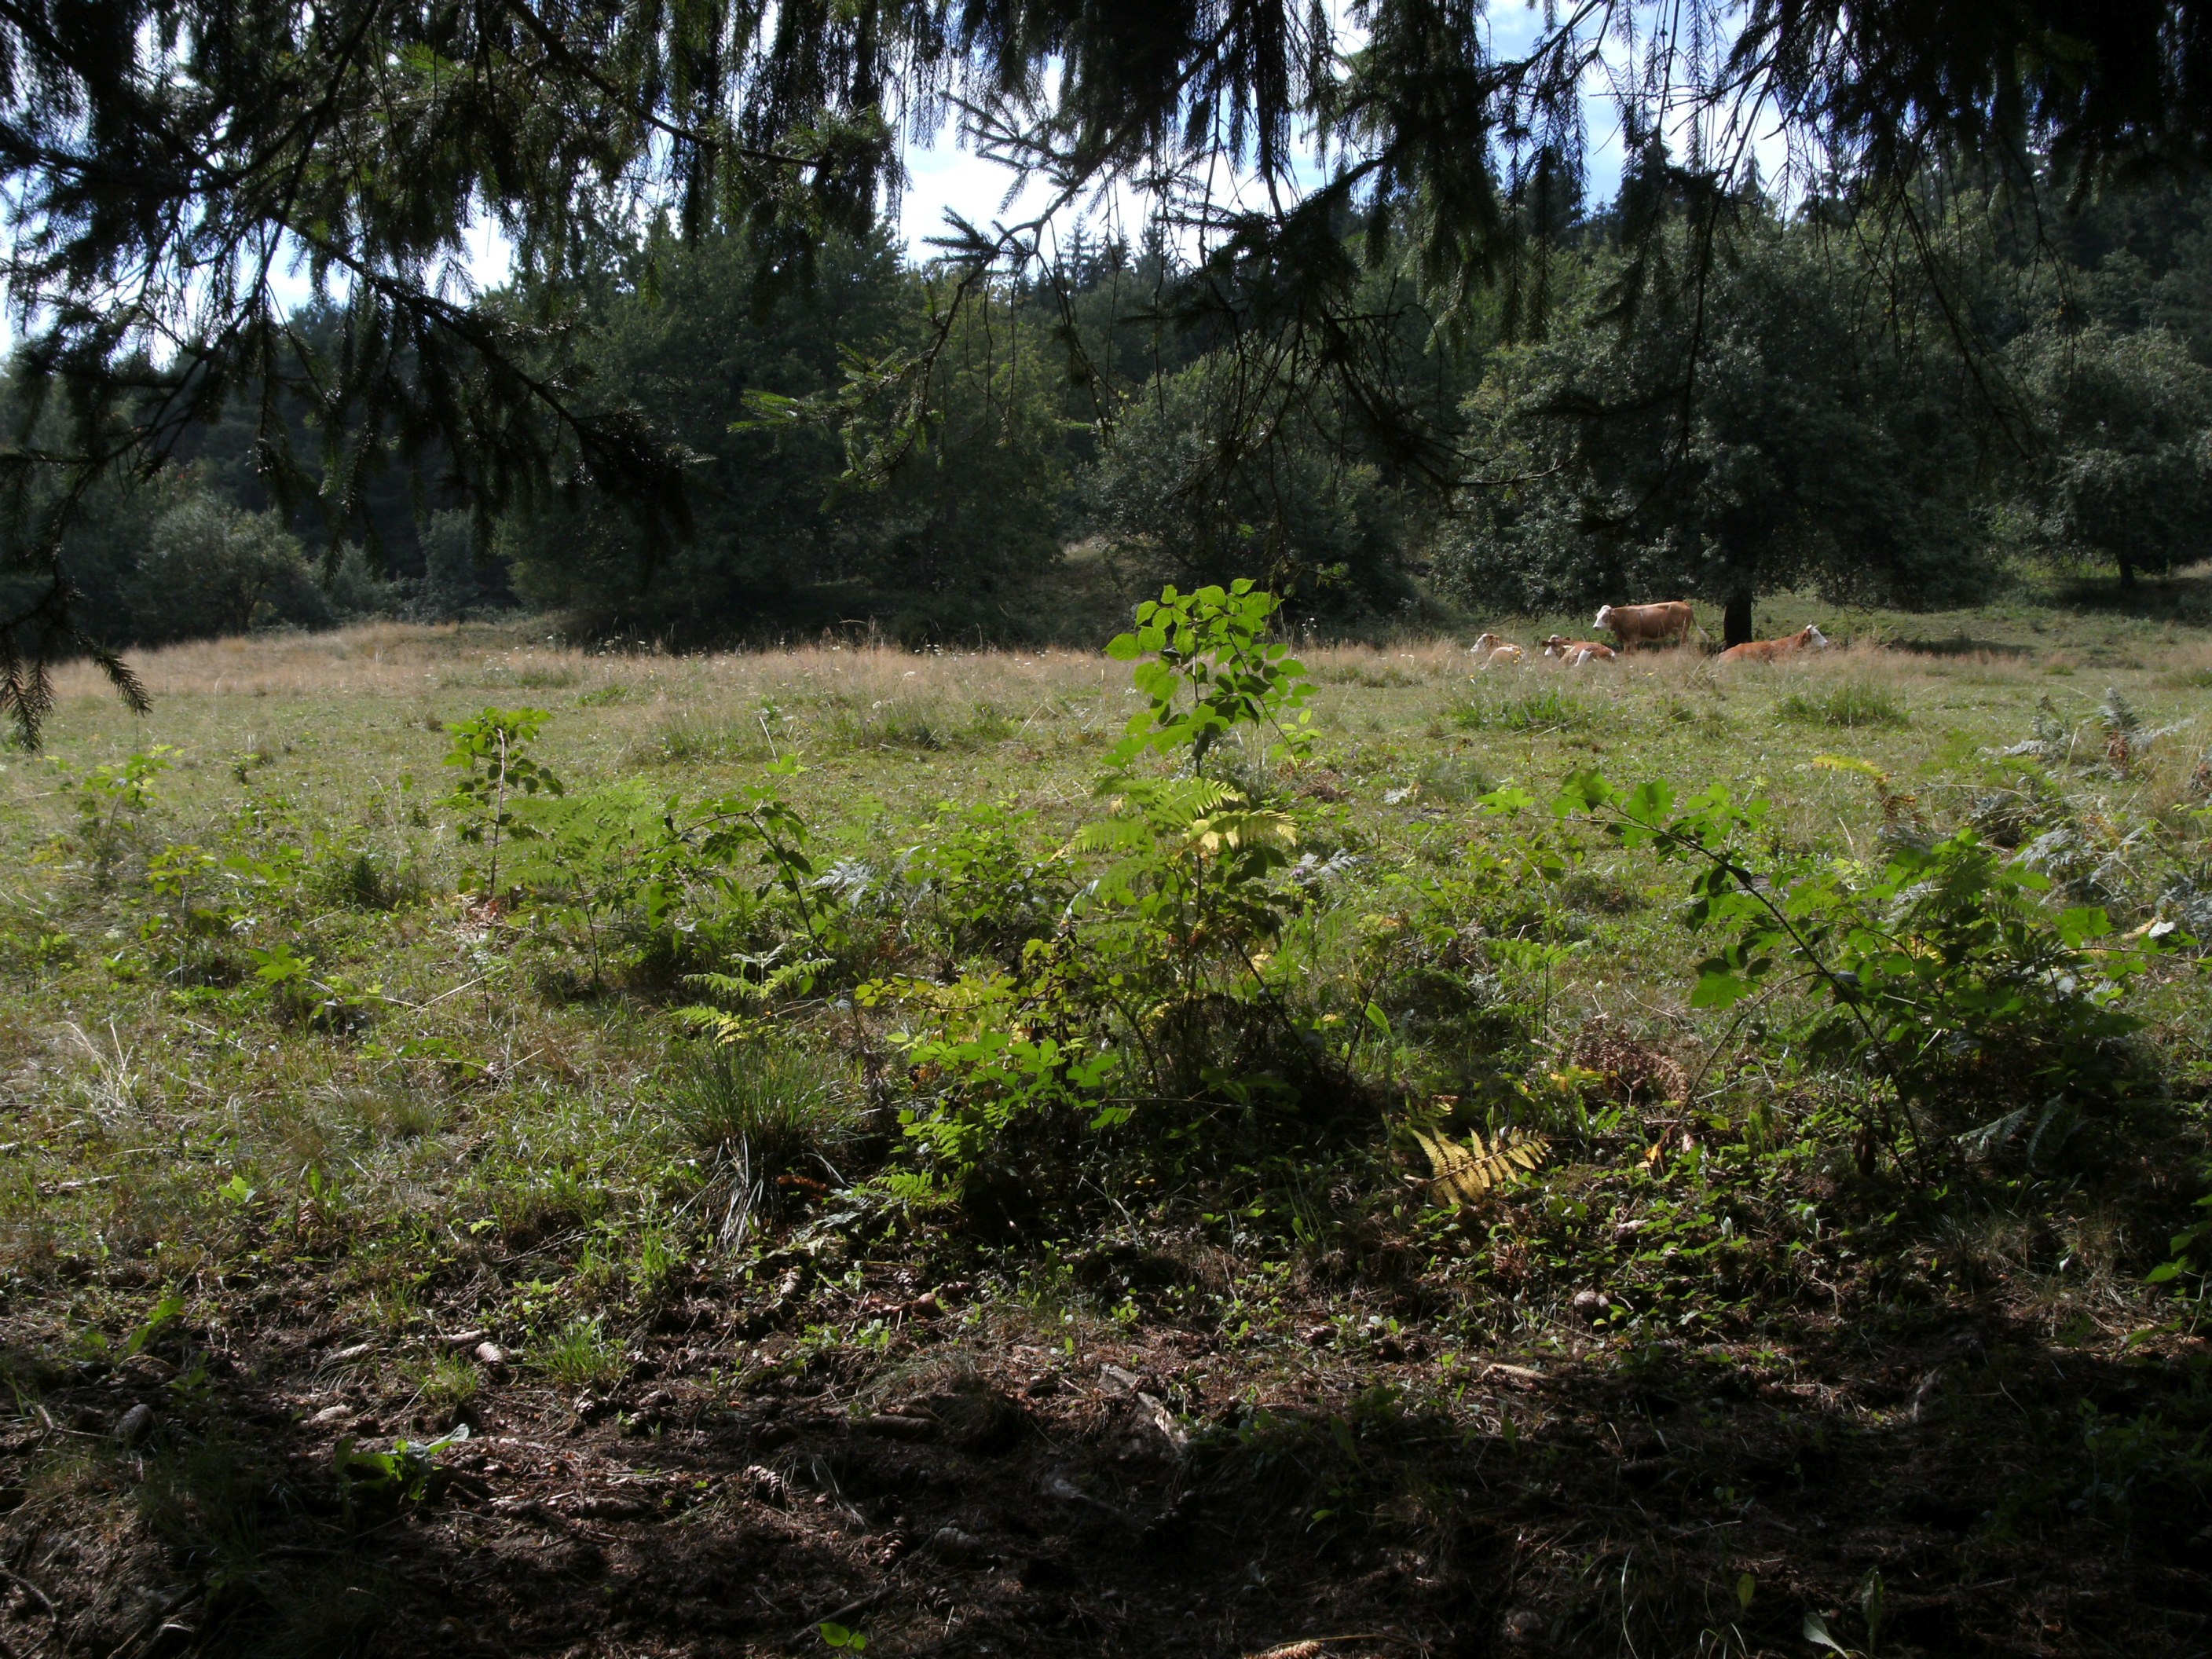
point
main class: Grassland
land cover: Grassland without tree/shrub cover
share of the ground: > 75 %
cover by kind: herbaceous plants 100 %
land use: Agriculture (excluding fallow land and kitchen gardens)
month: July
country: AT
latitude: 46.5857
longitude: 14.8136
